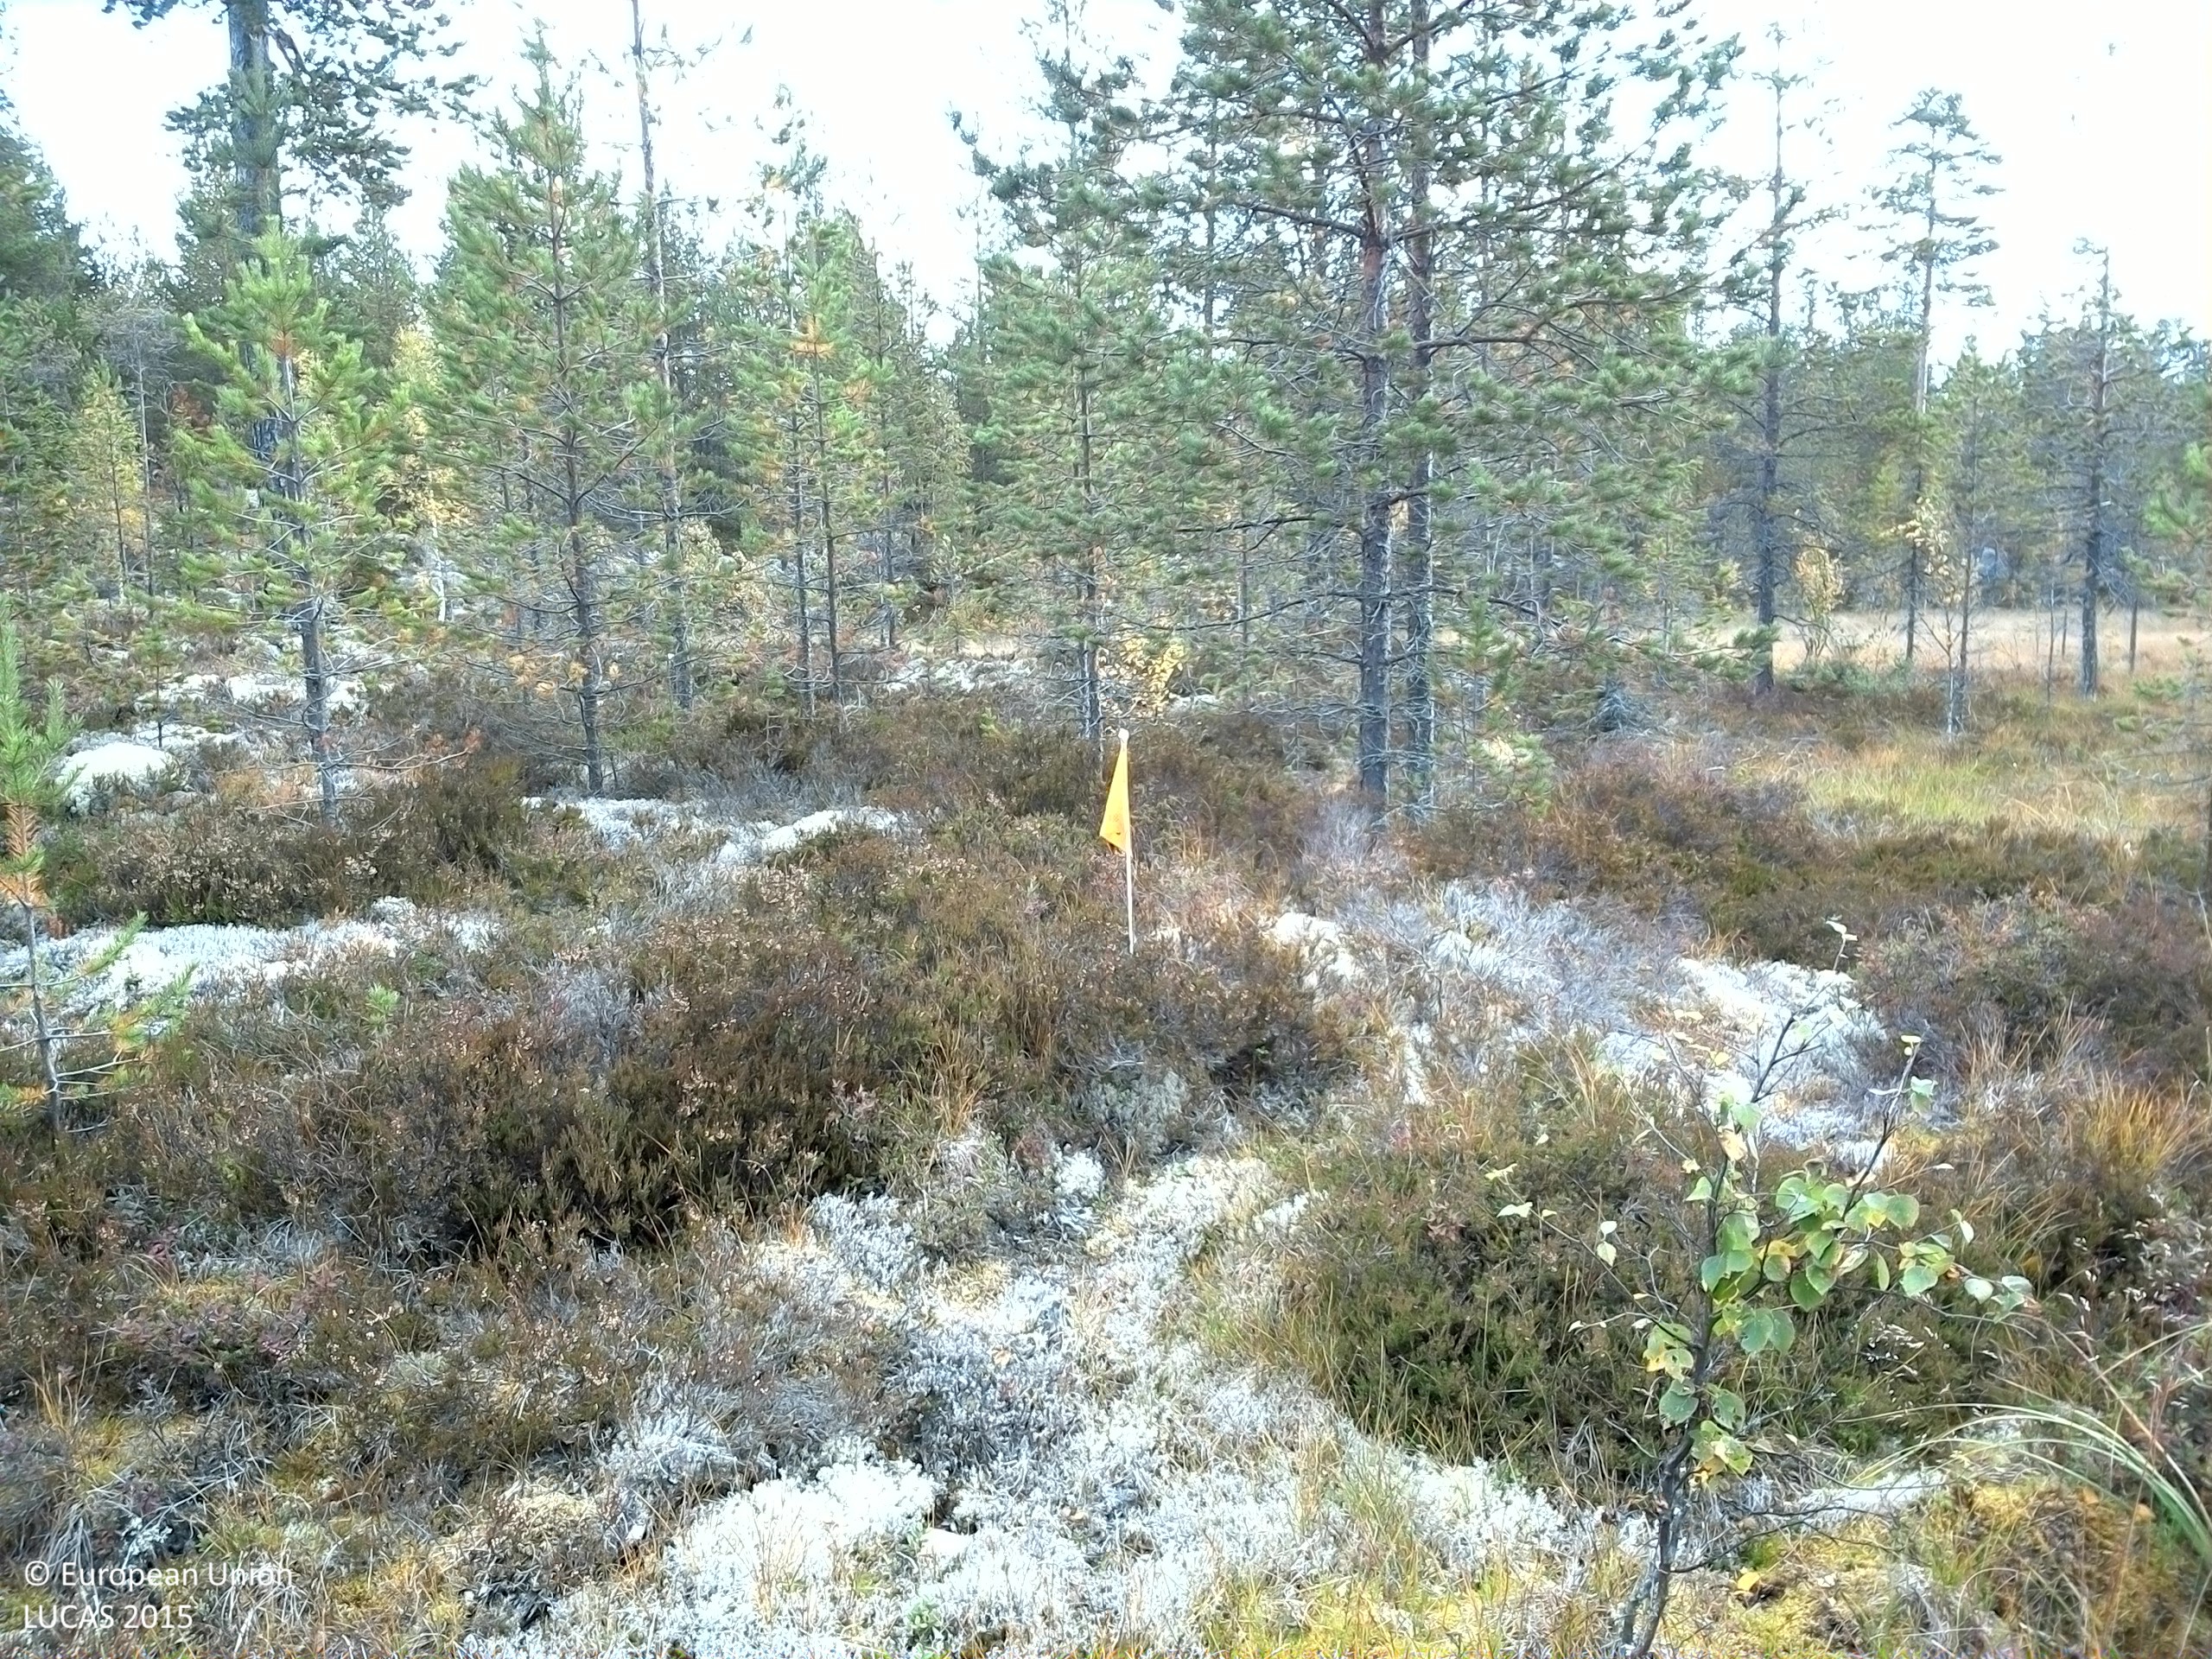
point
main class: Woodland
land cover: Pine dominated coniferous woodland
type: boreal forest
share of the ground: 10 - 25 %
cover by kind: lichens and mosses 35 %, shrubs 30 %, coniferous forest trees 15 %, herbaceous plants 15 %, broadleaved forest trees 5 %
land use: Forestry
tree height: < 5 m
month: September
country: SE
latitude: 61.5934
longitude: 14.9022
